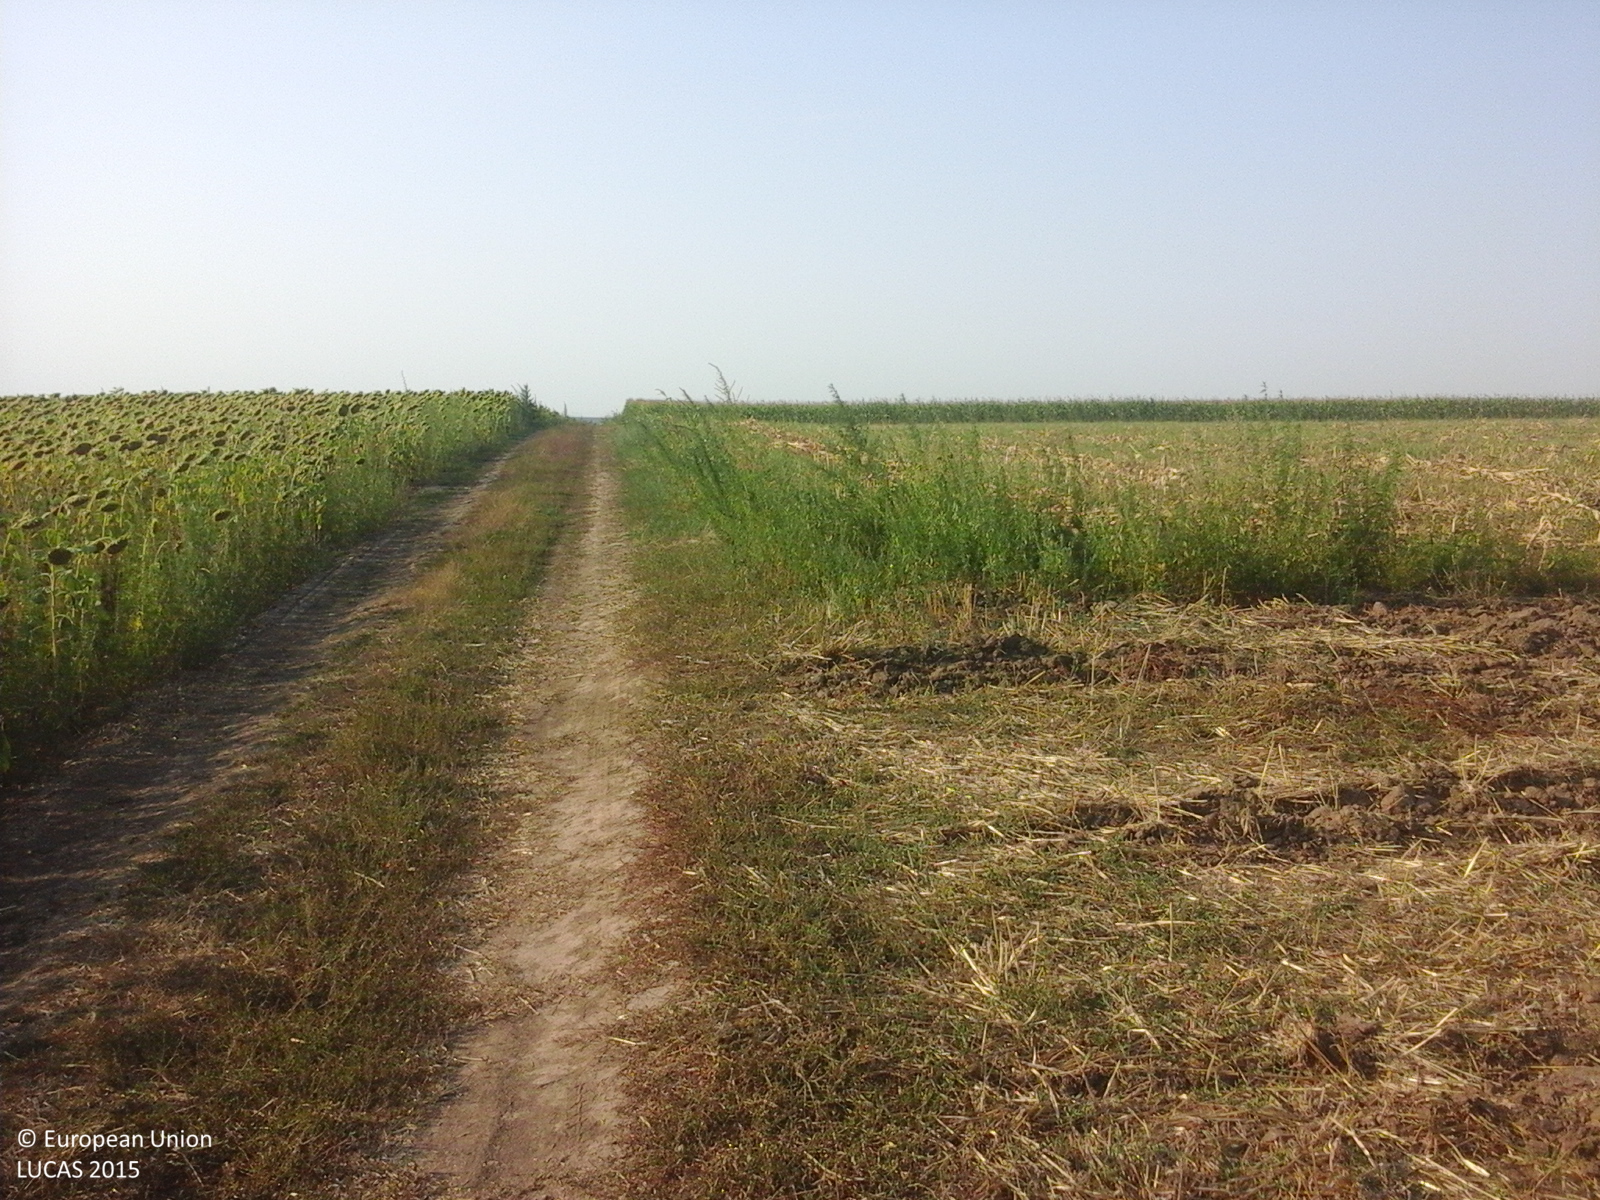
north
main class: Cropland
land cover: Sunflower
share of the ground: > 75 %
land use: Agriculture (excluding fallow land and kitchen gardens)
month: August
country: RO
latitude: 44.0755
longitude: 28.0735
